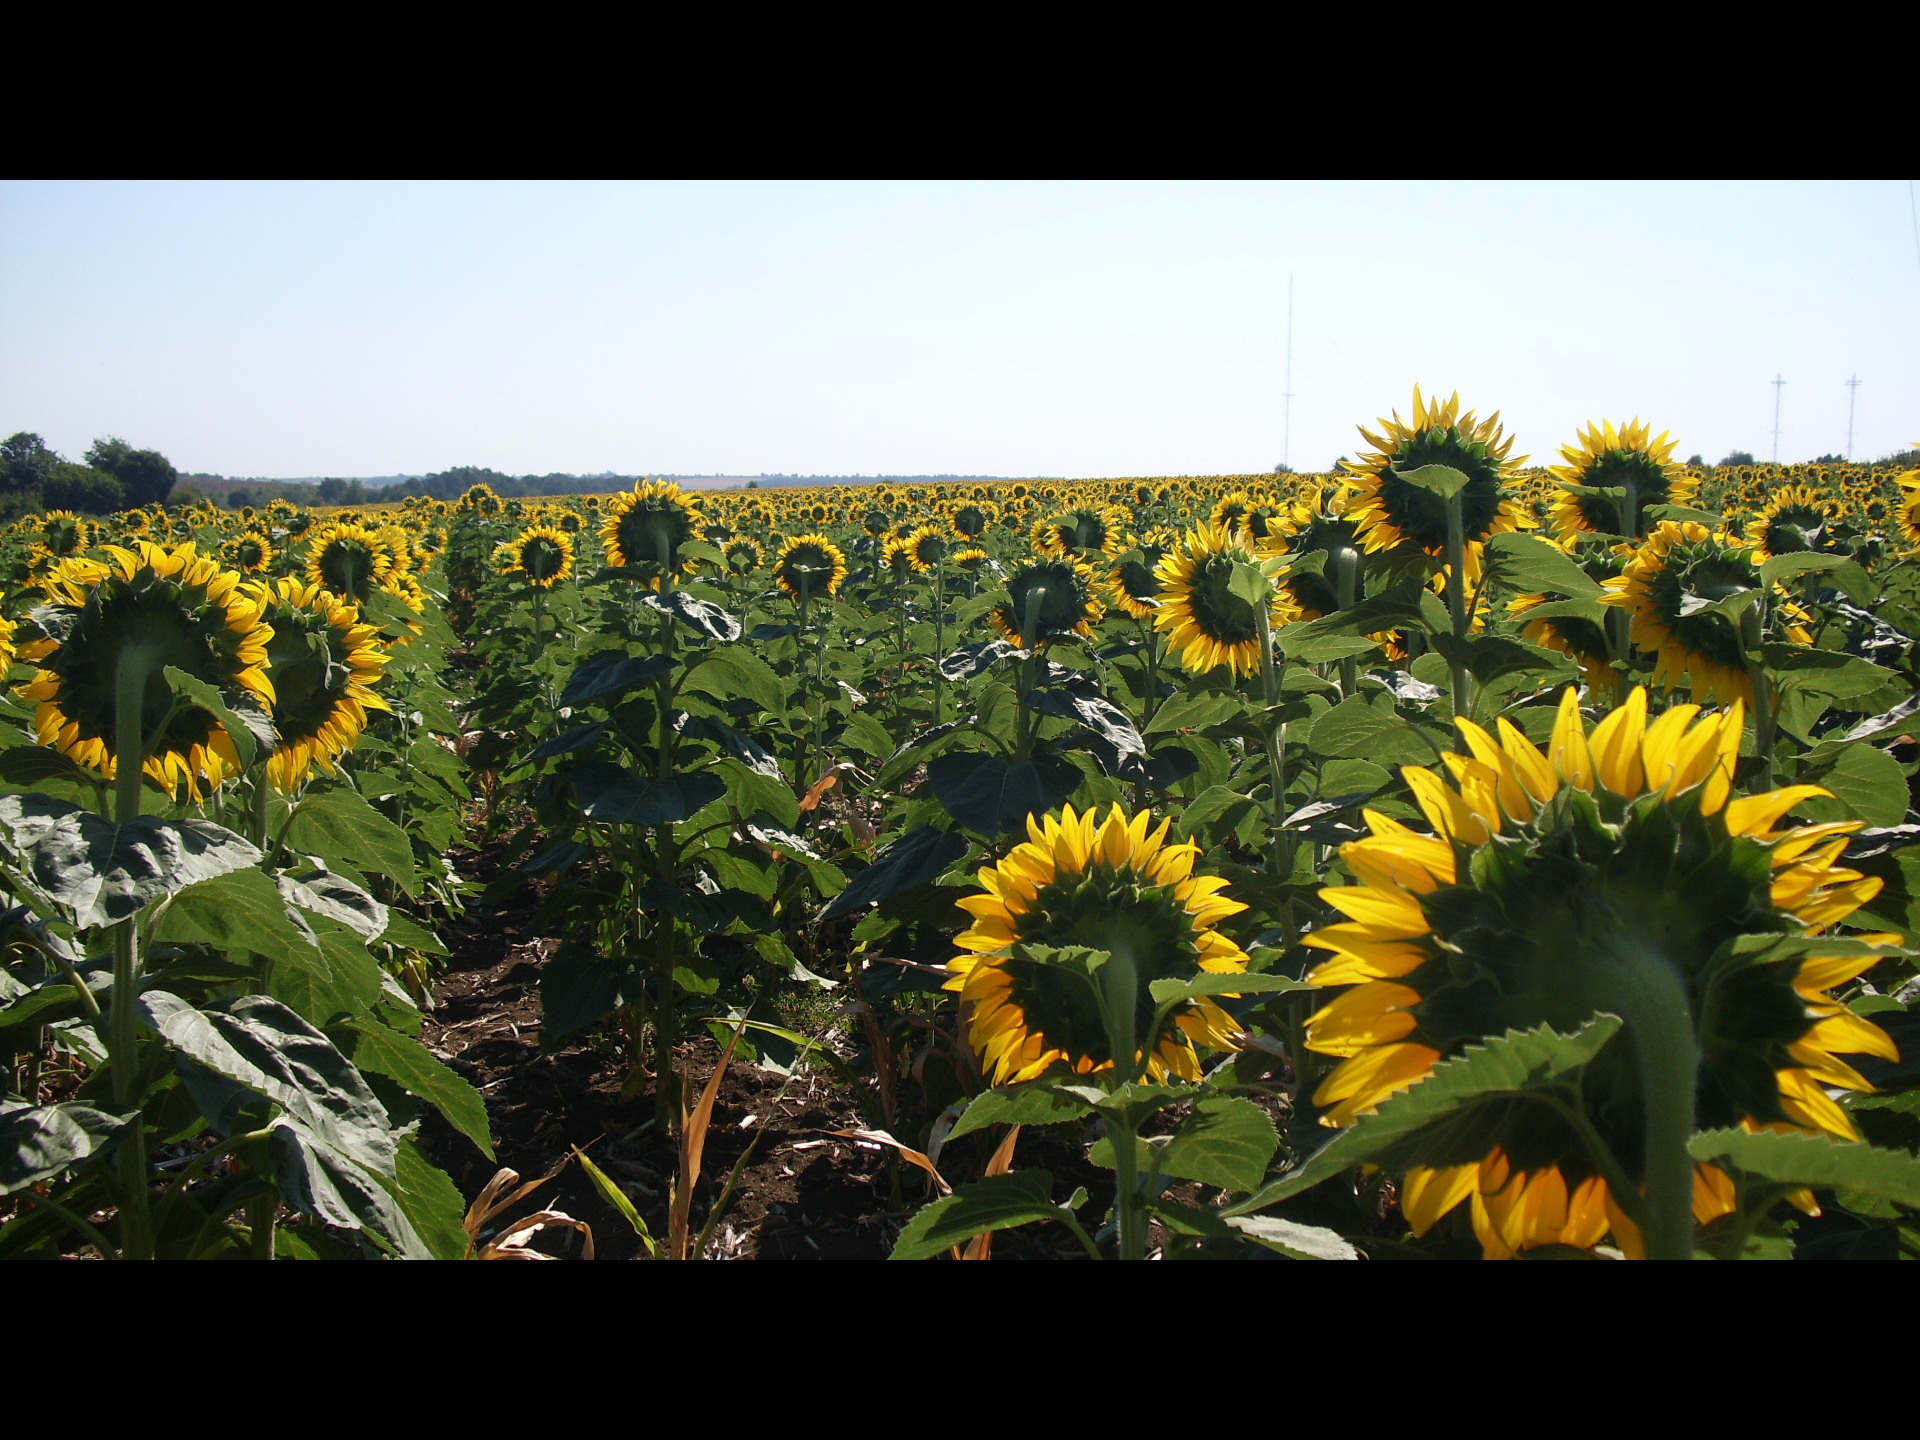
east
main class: Cropland
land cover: Sunflower
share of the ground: > 75 %
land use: Agriculture (excluding fallow land and kitchen gardens)
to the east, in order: Sunflower; Electric lines; Sunflower
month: July
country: BG
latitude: 43.8422
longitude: 22.6851
